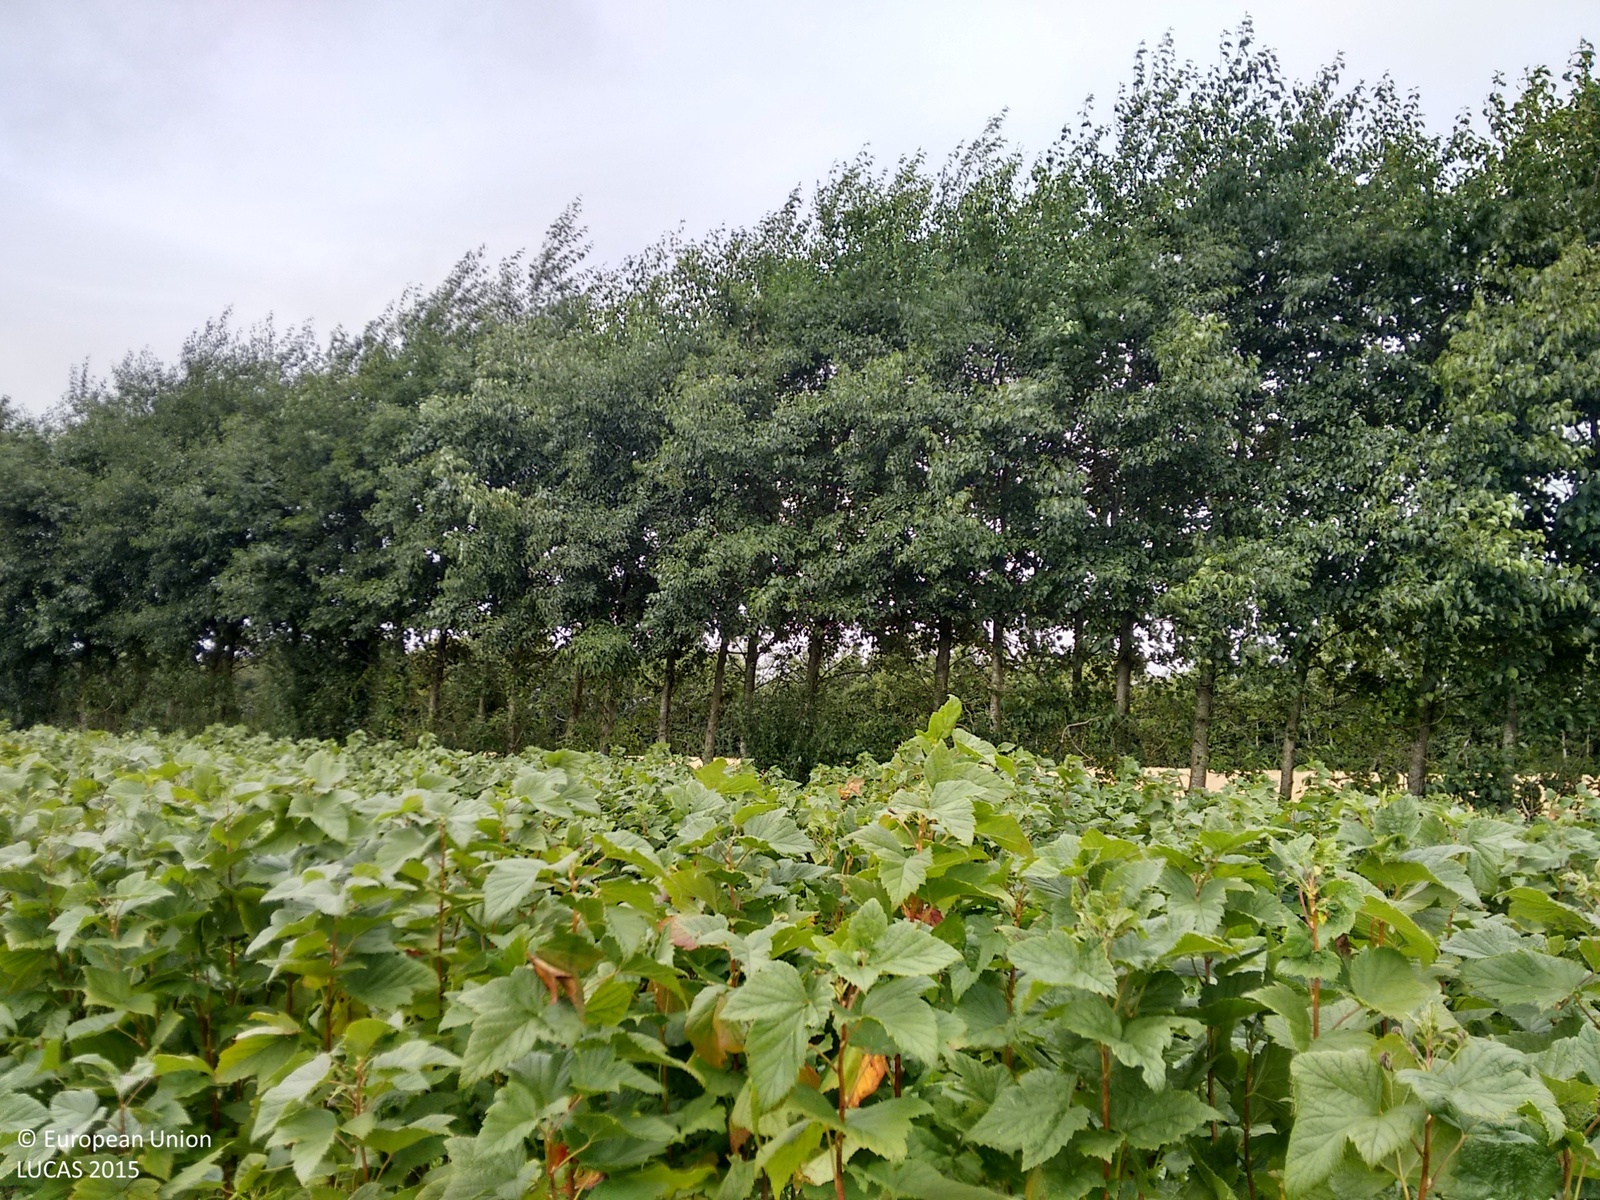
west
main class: Cropland
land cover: Other fruit trees and berries
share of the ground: 50 - 75 %
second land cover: Grassland without tree/shrub cover
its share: 50 - 75 %
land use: Agriculture (excluding fallow land and kitchen gardens)
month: August
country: IE
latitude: 52.4995
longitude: -6.6147
